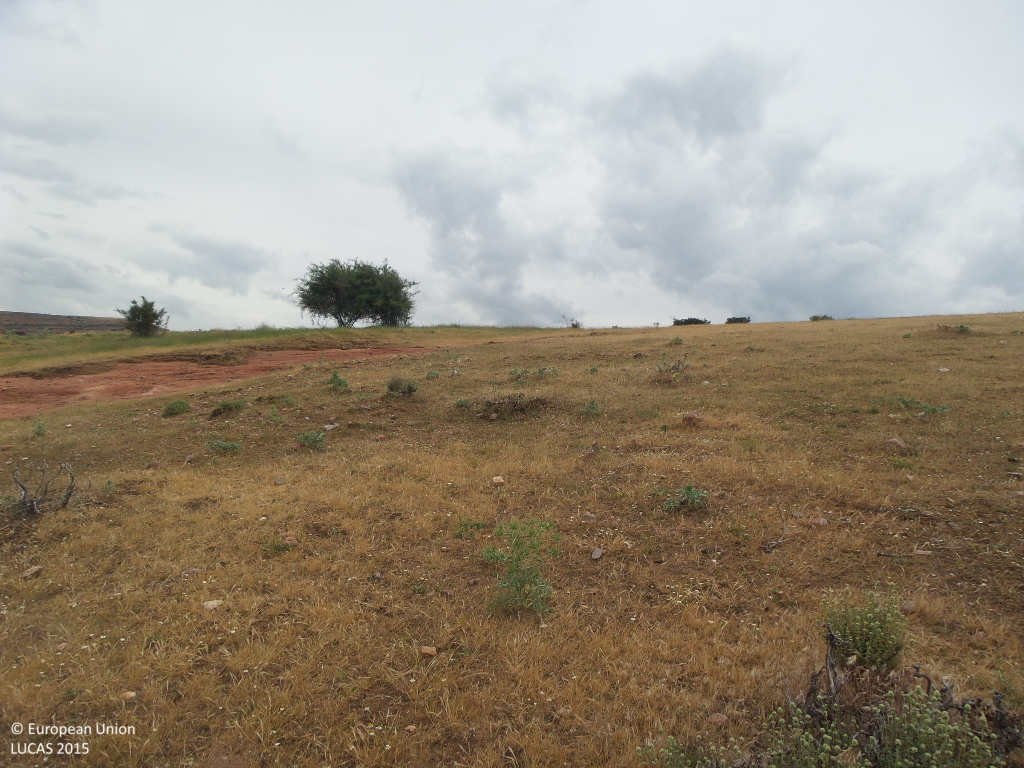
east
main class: Grassland
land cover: Grassland with sparse tree/shrub cover
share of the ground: > 75 %
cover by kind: herbaceous plants 95 %, broadleaved forest trees 5 %
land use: Agriculture (excluding fallow land and kitchen gardens)
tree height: > 5 m
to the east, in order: Grassland with sparse tree/shrub cover; Rivers and streams; Grassland without tree/shrub cover
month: June
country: ES
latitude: 41.3178
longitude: -3.1461
